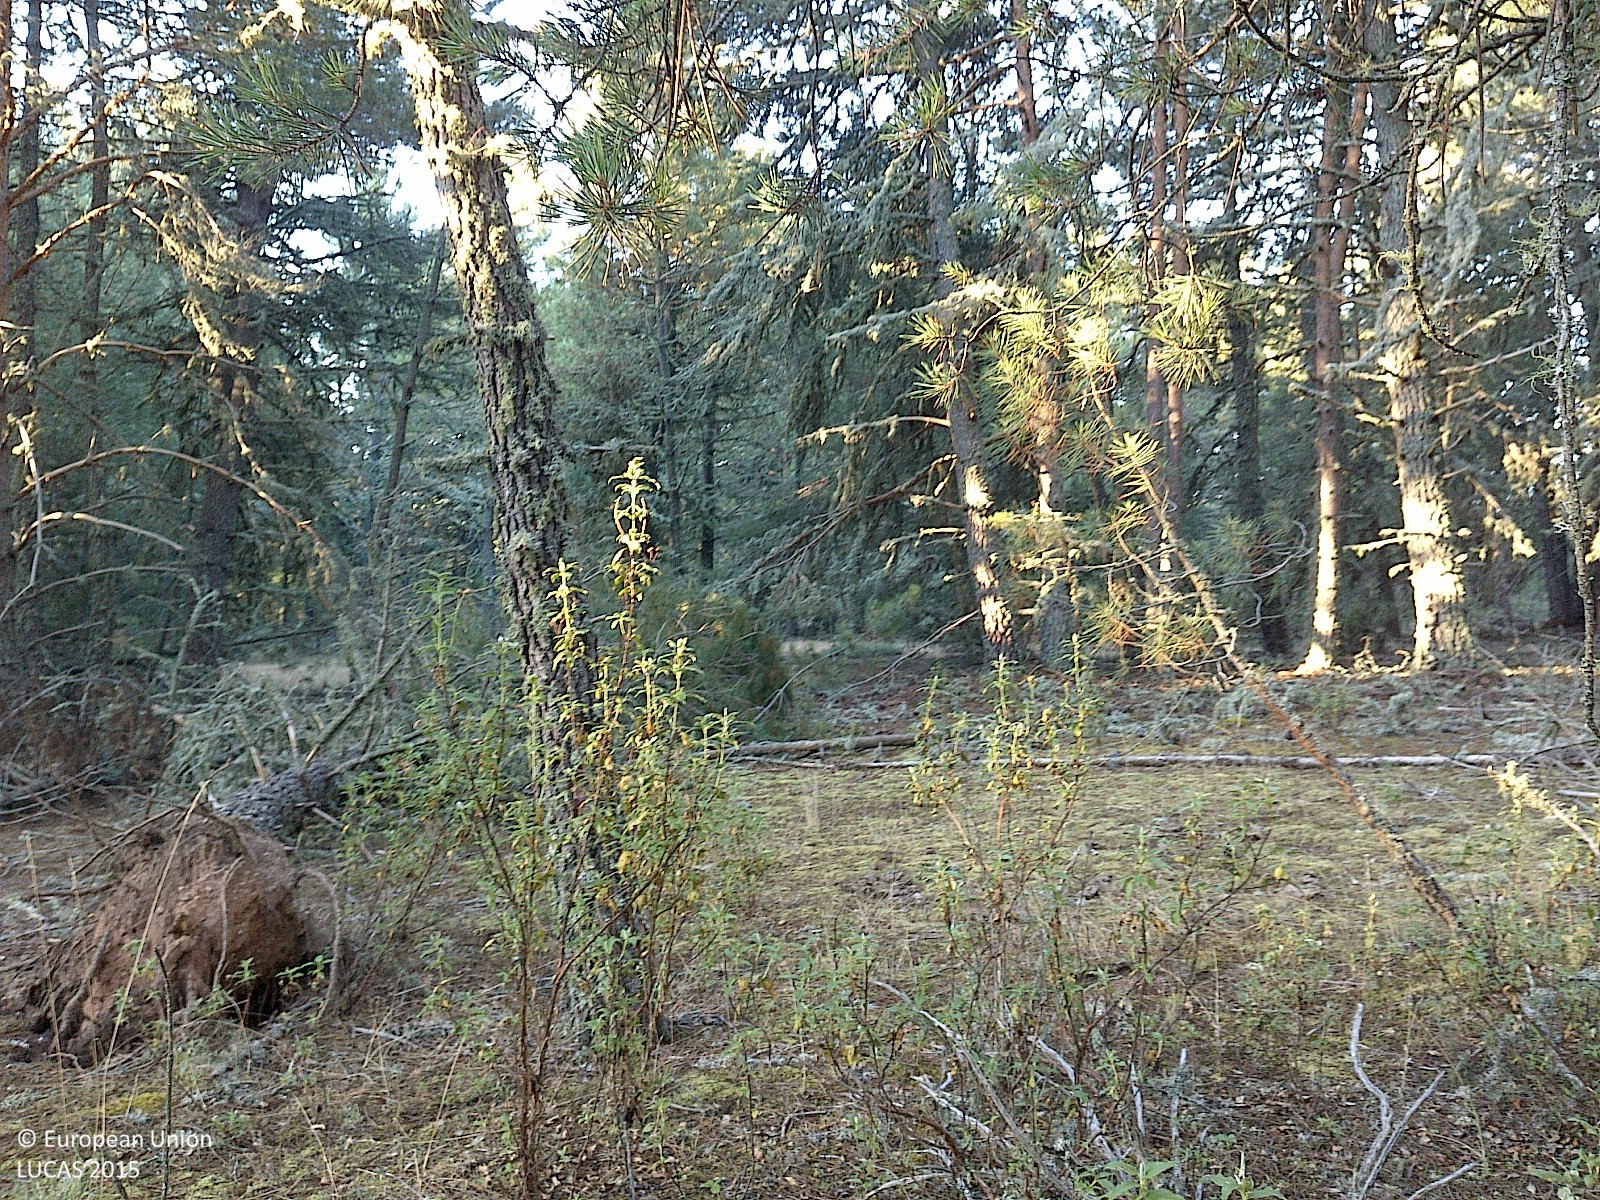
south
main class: Woodland
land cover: Pine dominated coniferous woodland
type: coniferous forest of the mediterranean region
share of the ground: > 75 %
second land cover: Grassland without tree/shrub cover
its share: 10 - 25 %
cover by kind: coniferous forest trees 80 %, herbaceous plants 10 %, shrubs 5 %, lichens and mosses 5 %
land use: Forestry
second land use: Agriculture (excluding fallow land and kitchen gardens)
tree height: > 5 m
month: July
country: ES
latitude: 41.8519
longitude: -3.1156
